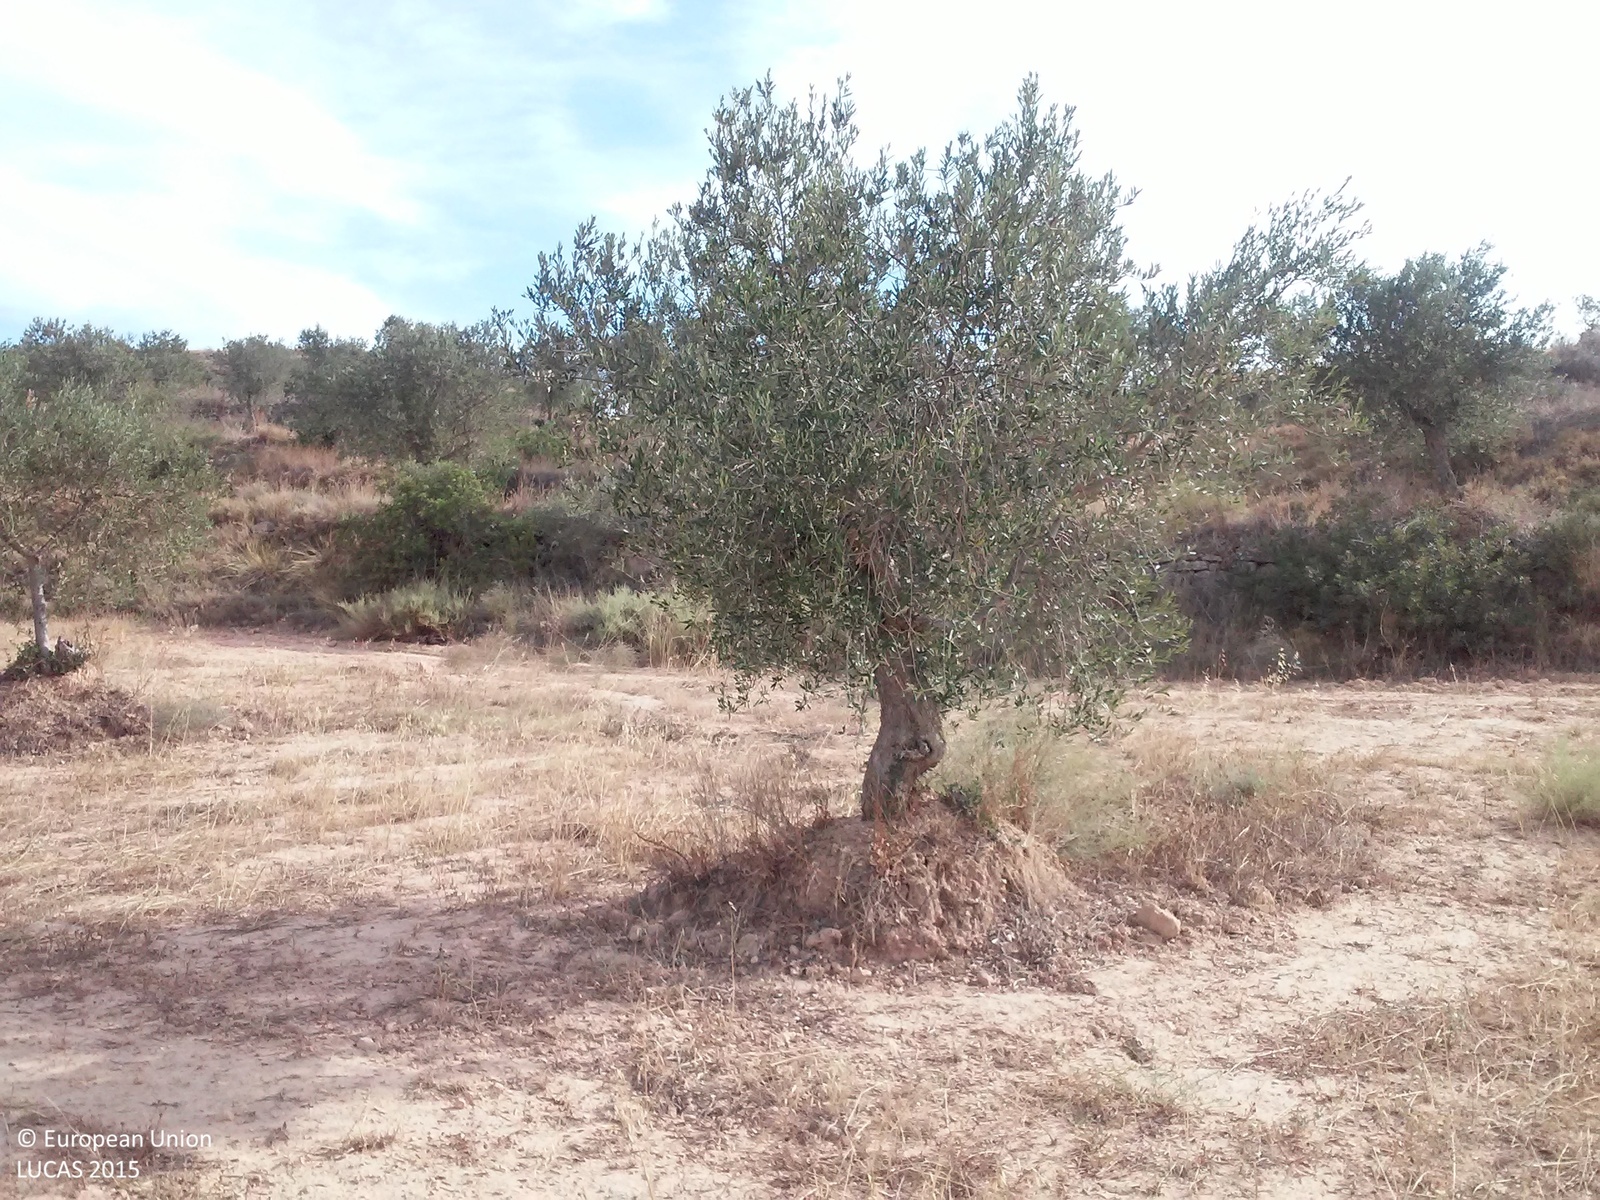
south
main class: Cropland
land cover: Olive groves
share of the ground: 10 - 25 %
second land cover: Other bare soil
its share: > 75 %
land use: Agriculture (excluding fallow land and kitchen gardens)
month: August
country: ES
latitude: 41.4428
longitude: 0.4971
